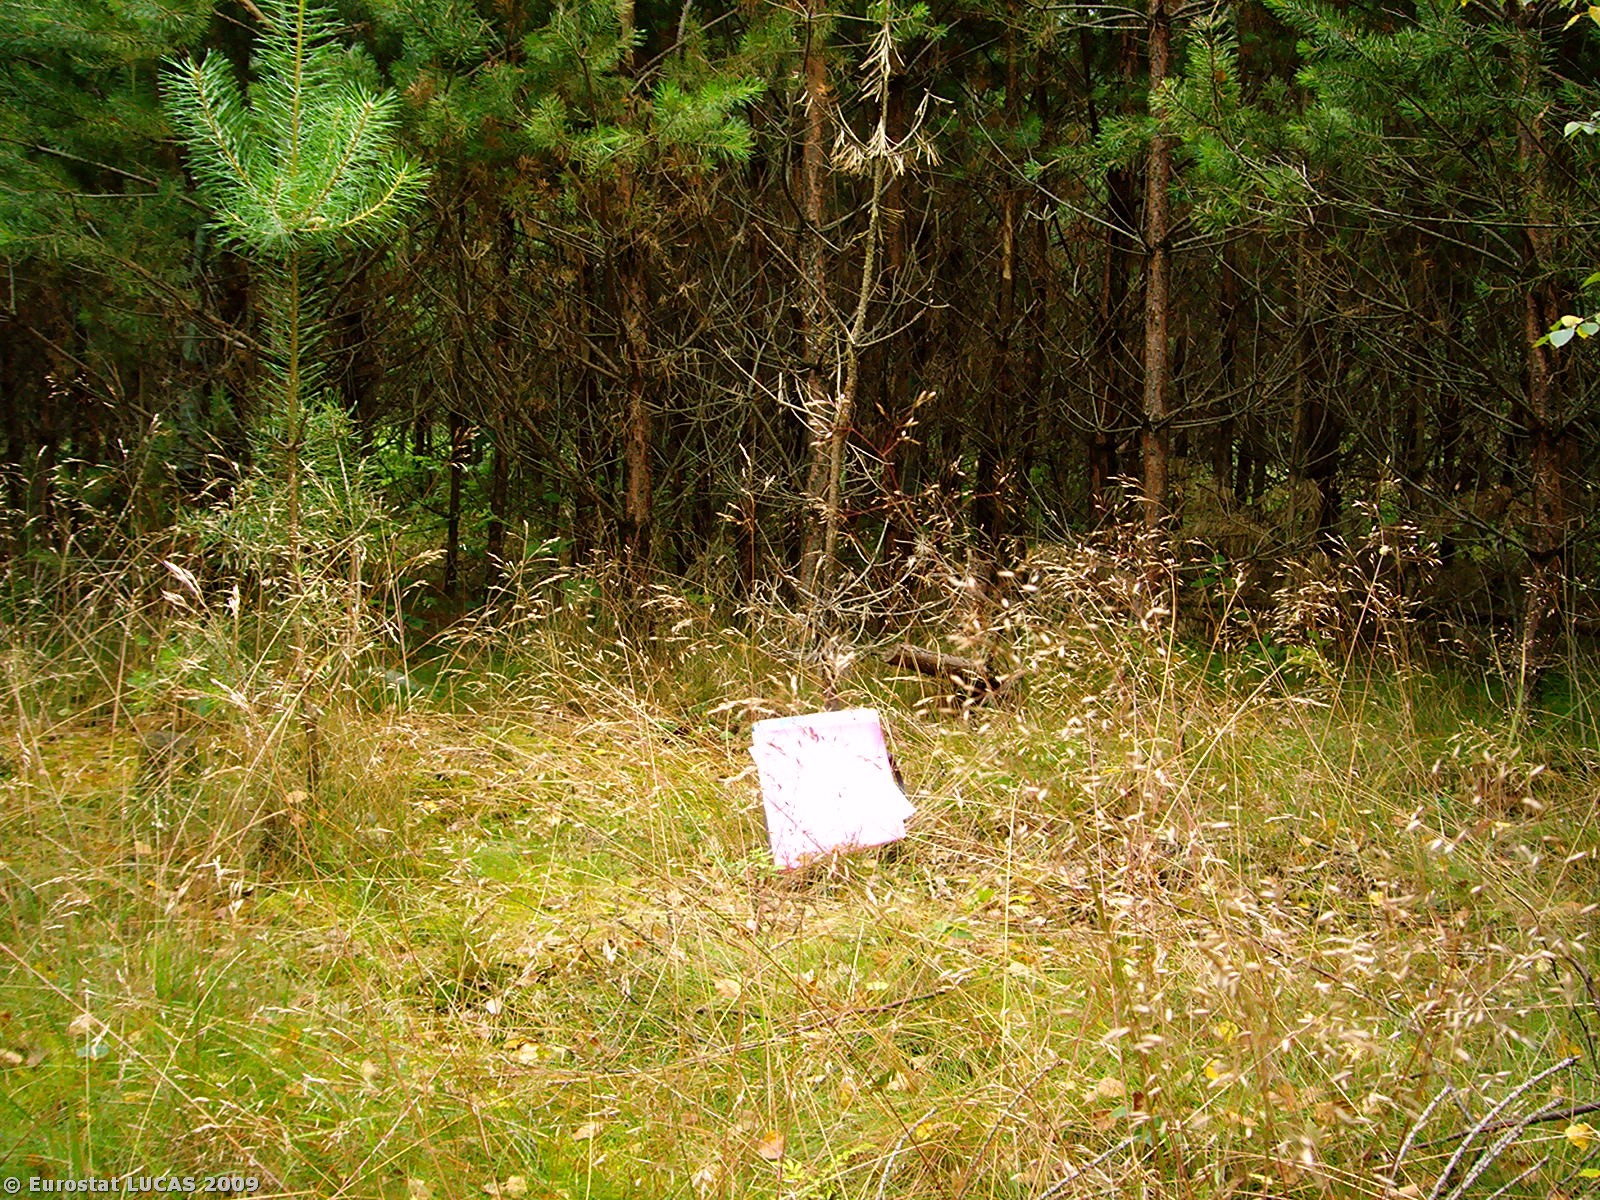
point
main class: Woodland
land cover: Coniferous woodland
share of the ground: > 75 %
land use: Forestry
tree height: < 5 m
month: July
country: PL
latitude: 52.5719
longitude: 15.1524
